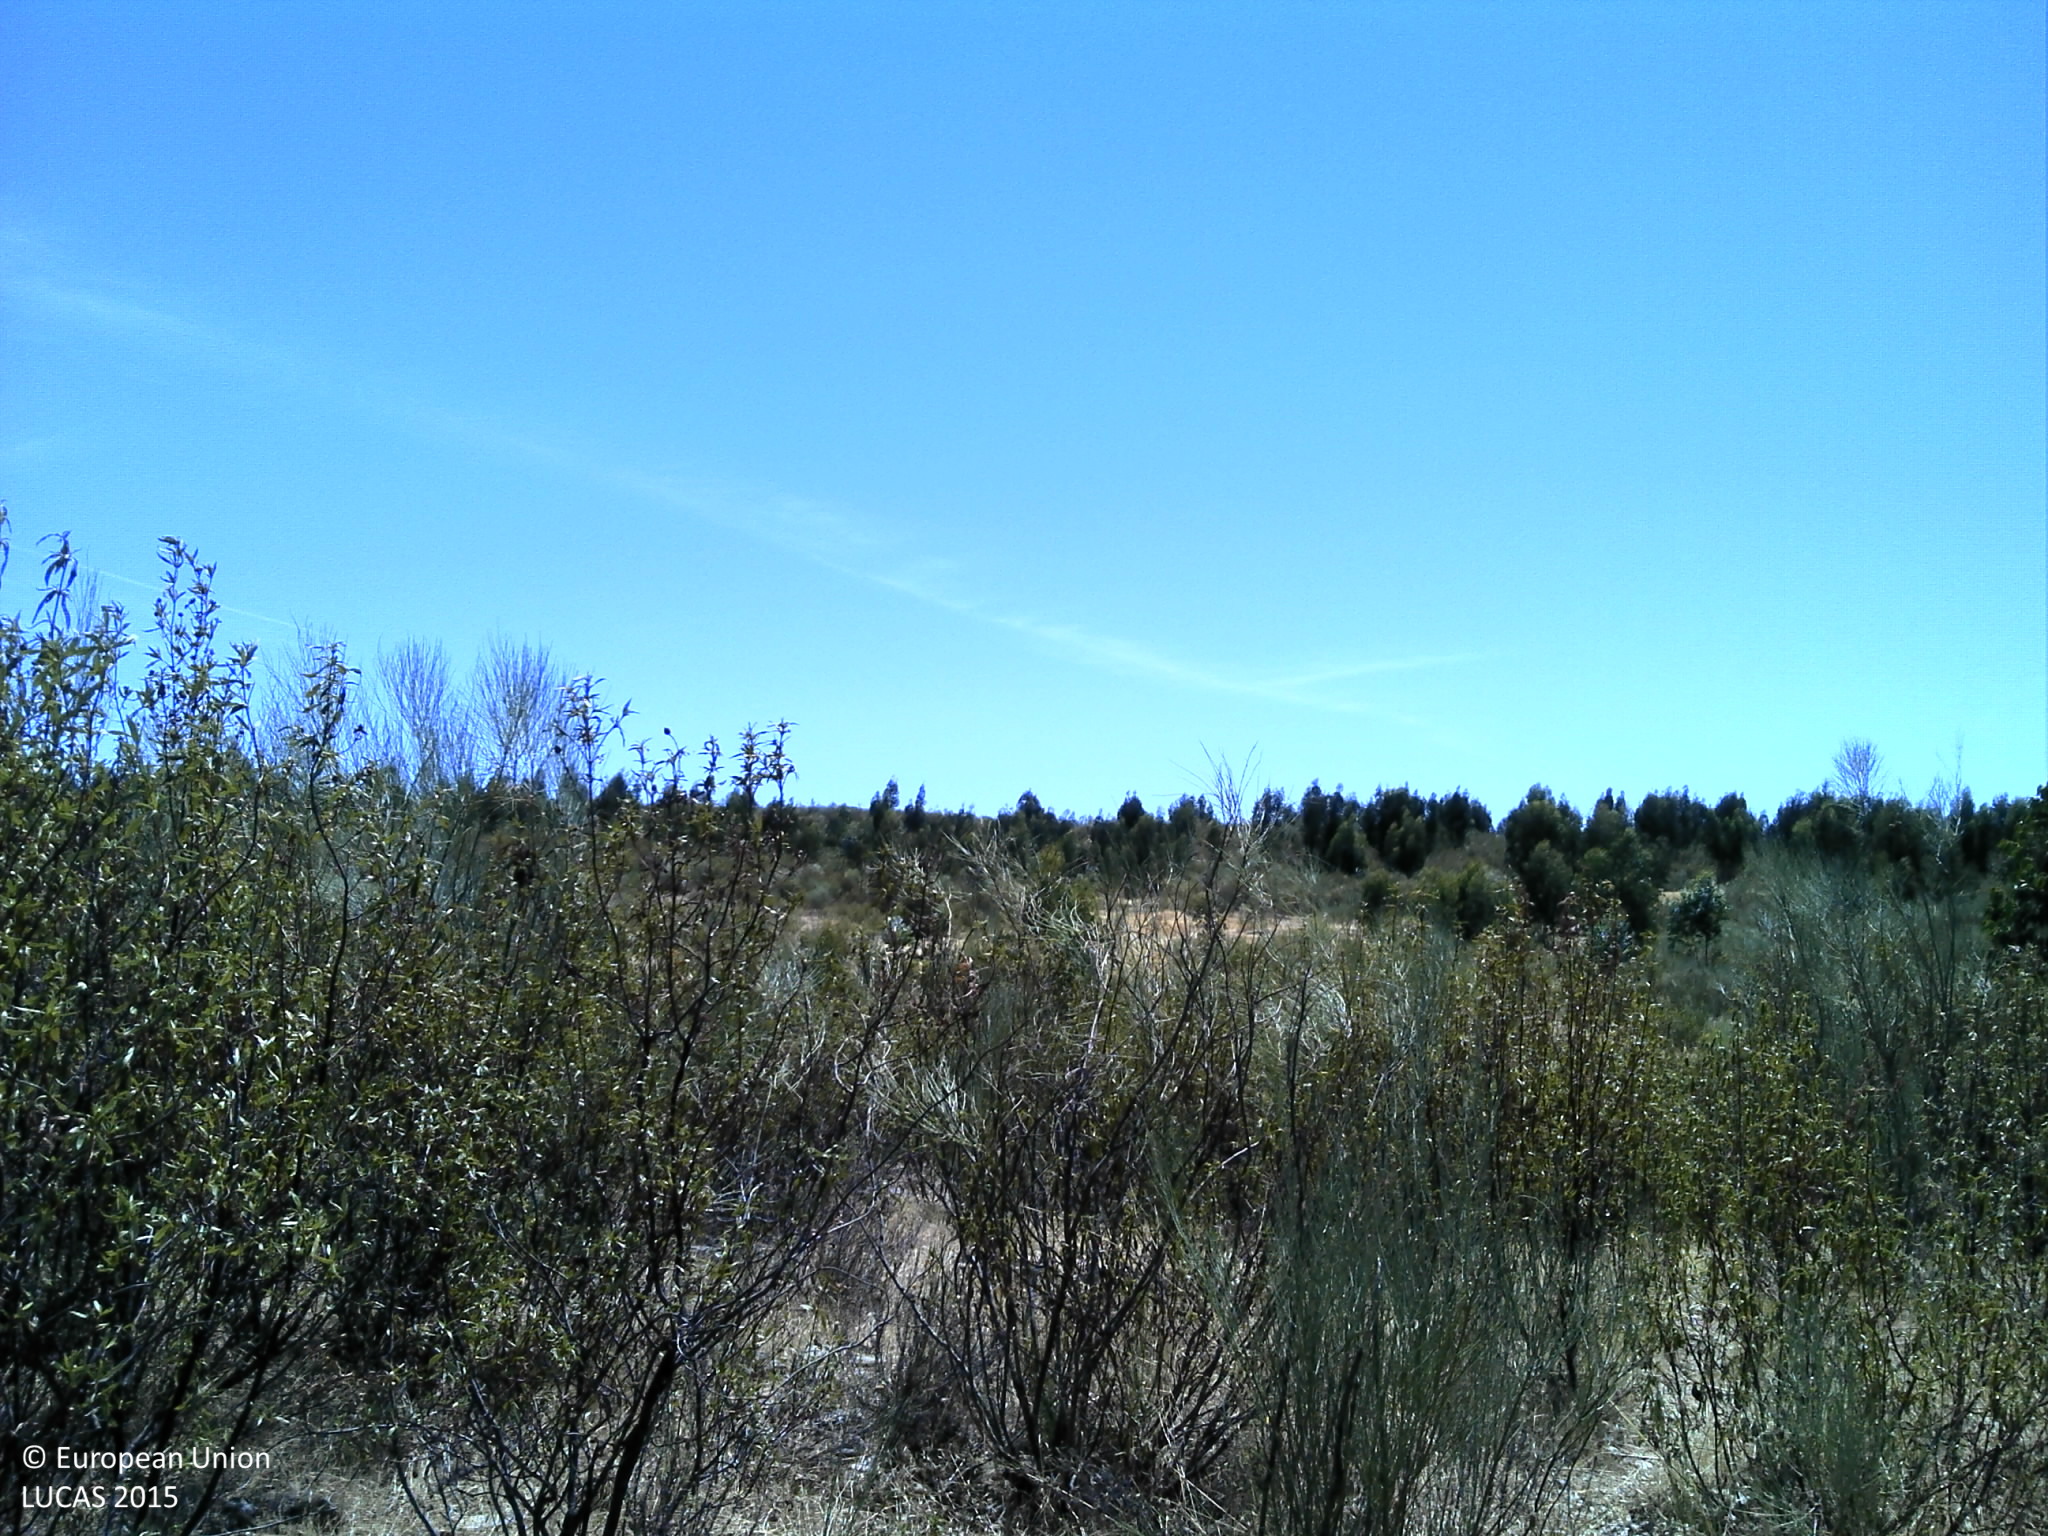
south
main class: Woodland
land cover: Broadleaved woodland
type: exotic forest
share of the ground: 10 - 25 %
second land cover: Shrubland without tree cover
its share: > 75 %
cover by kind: shrubs 75 %, herbaceous plants 15 %, broadleaved forest trees 10 %
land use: Forestry
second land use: Agriculture (excluding fallow land and kitchen gardens)
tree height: > 5 m
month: August
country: PT
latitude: 39.5539
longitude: -7.4690
